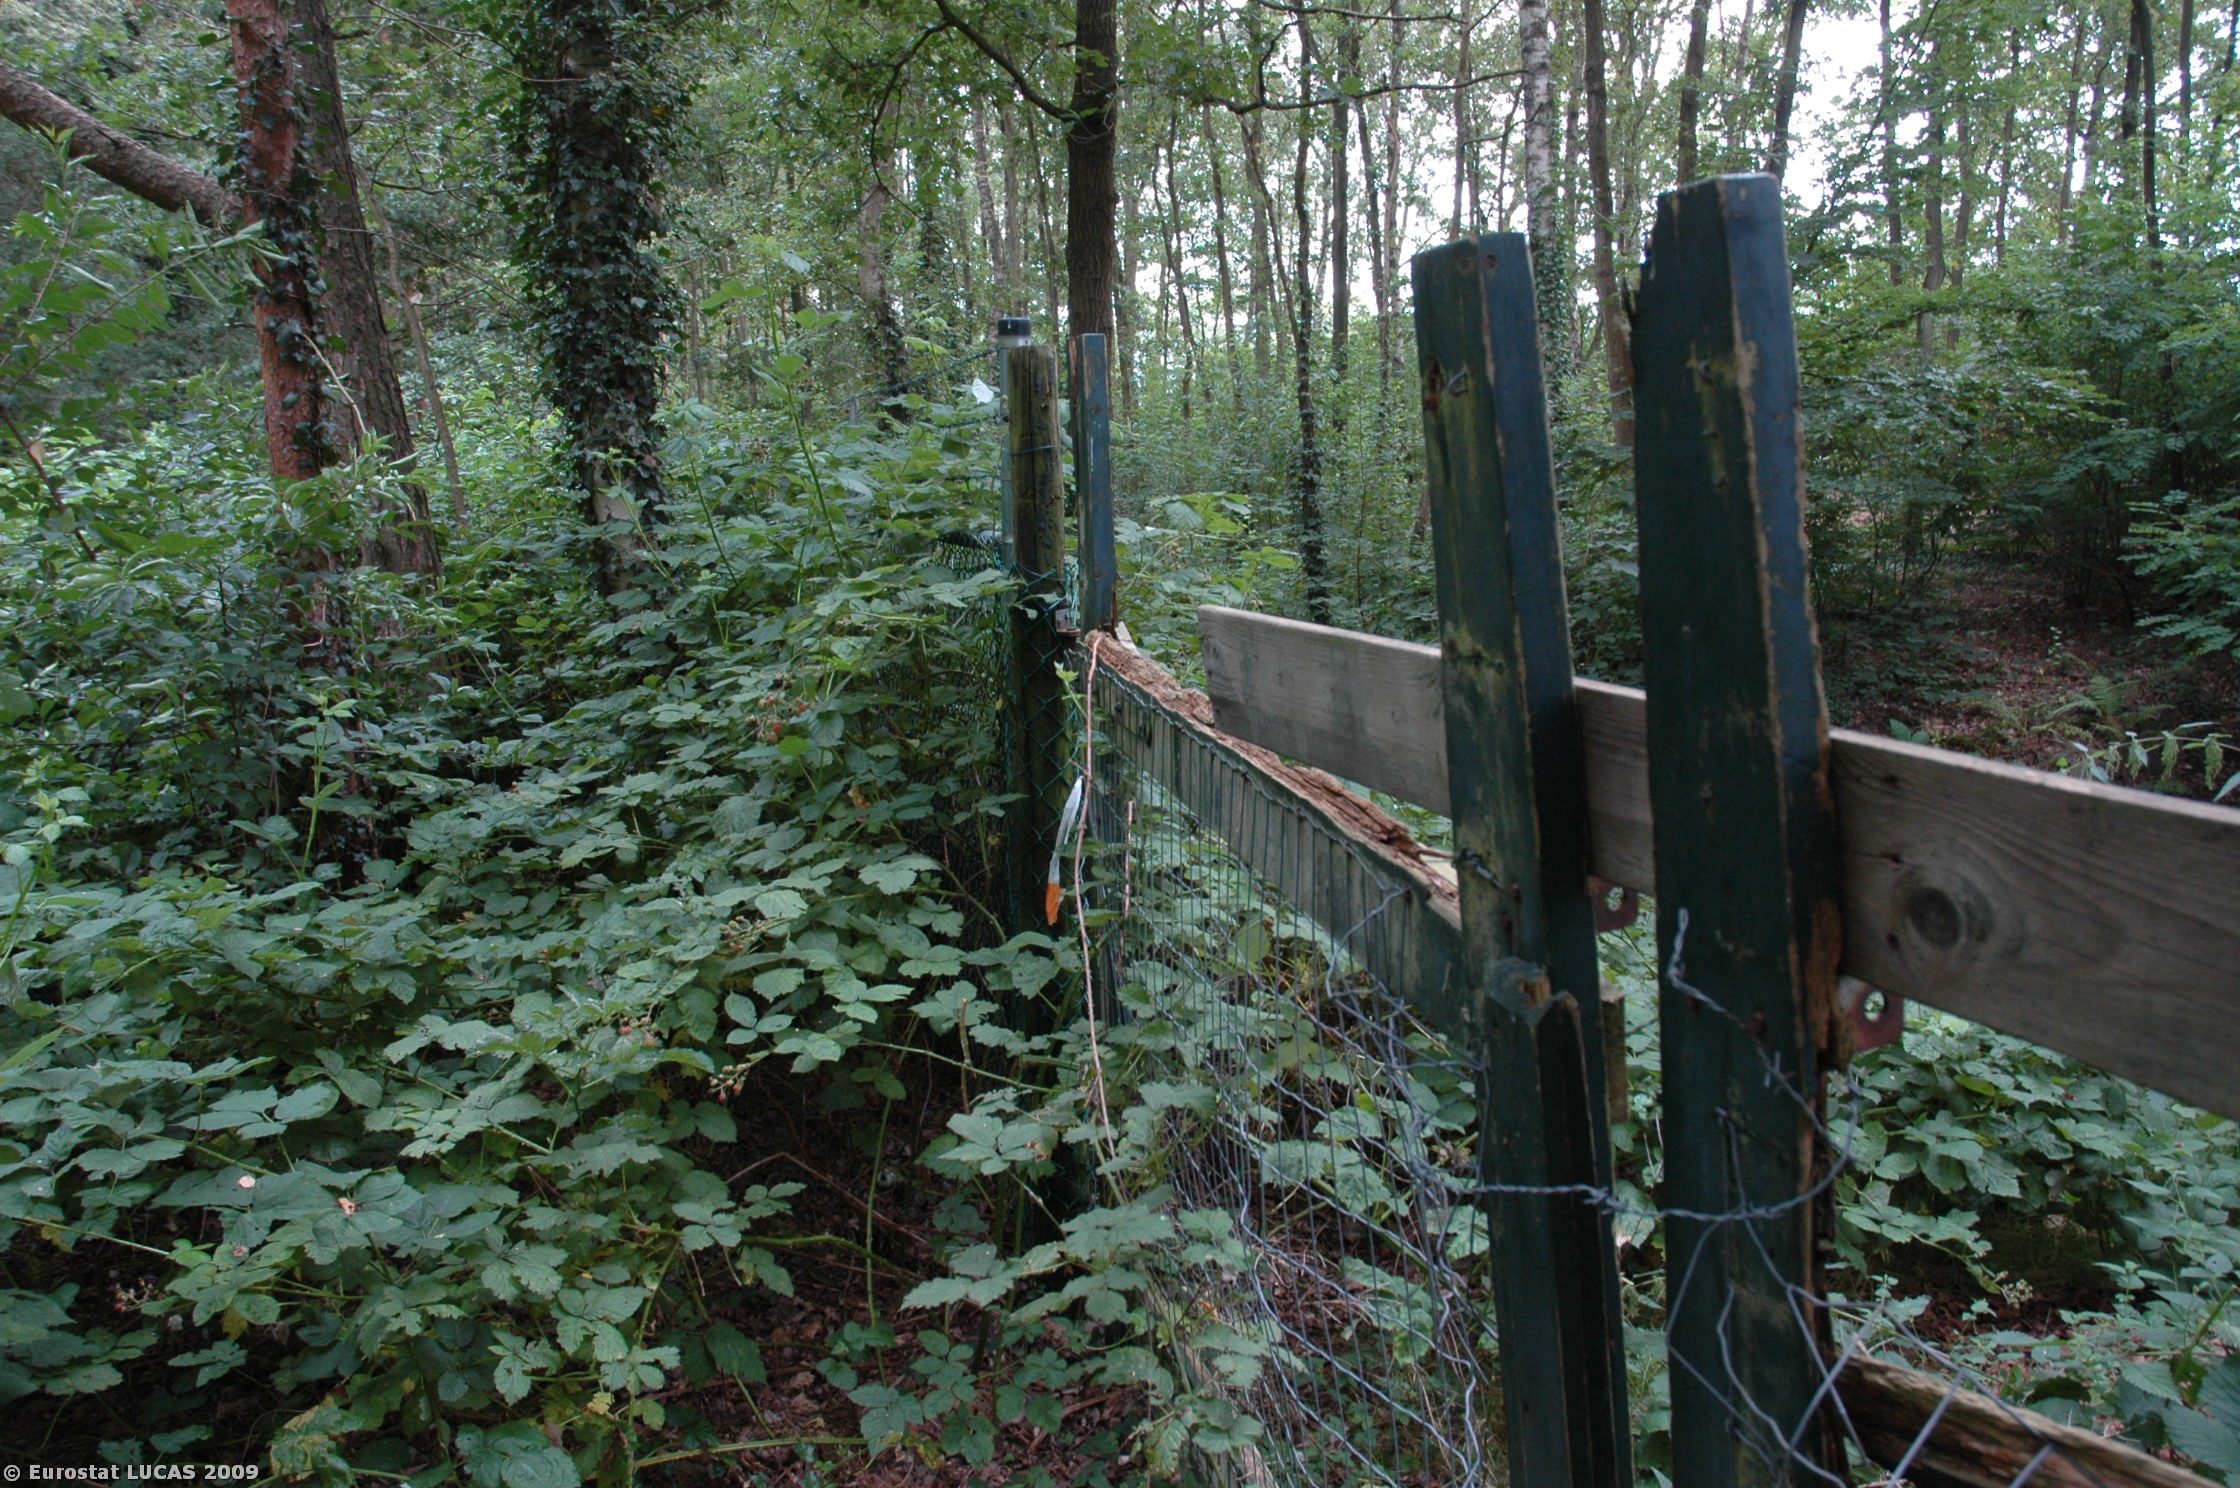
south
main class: Woodland
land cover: Broadleaved woodland
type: plantations and self-sown exotic forest
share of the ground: > 75 %
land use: Amenities, museums, leisure
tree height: > 5 m
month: August
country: NL
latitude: 52.4564
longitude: 6.0701
